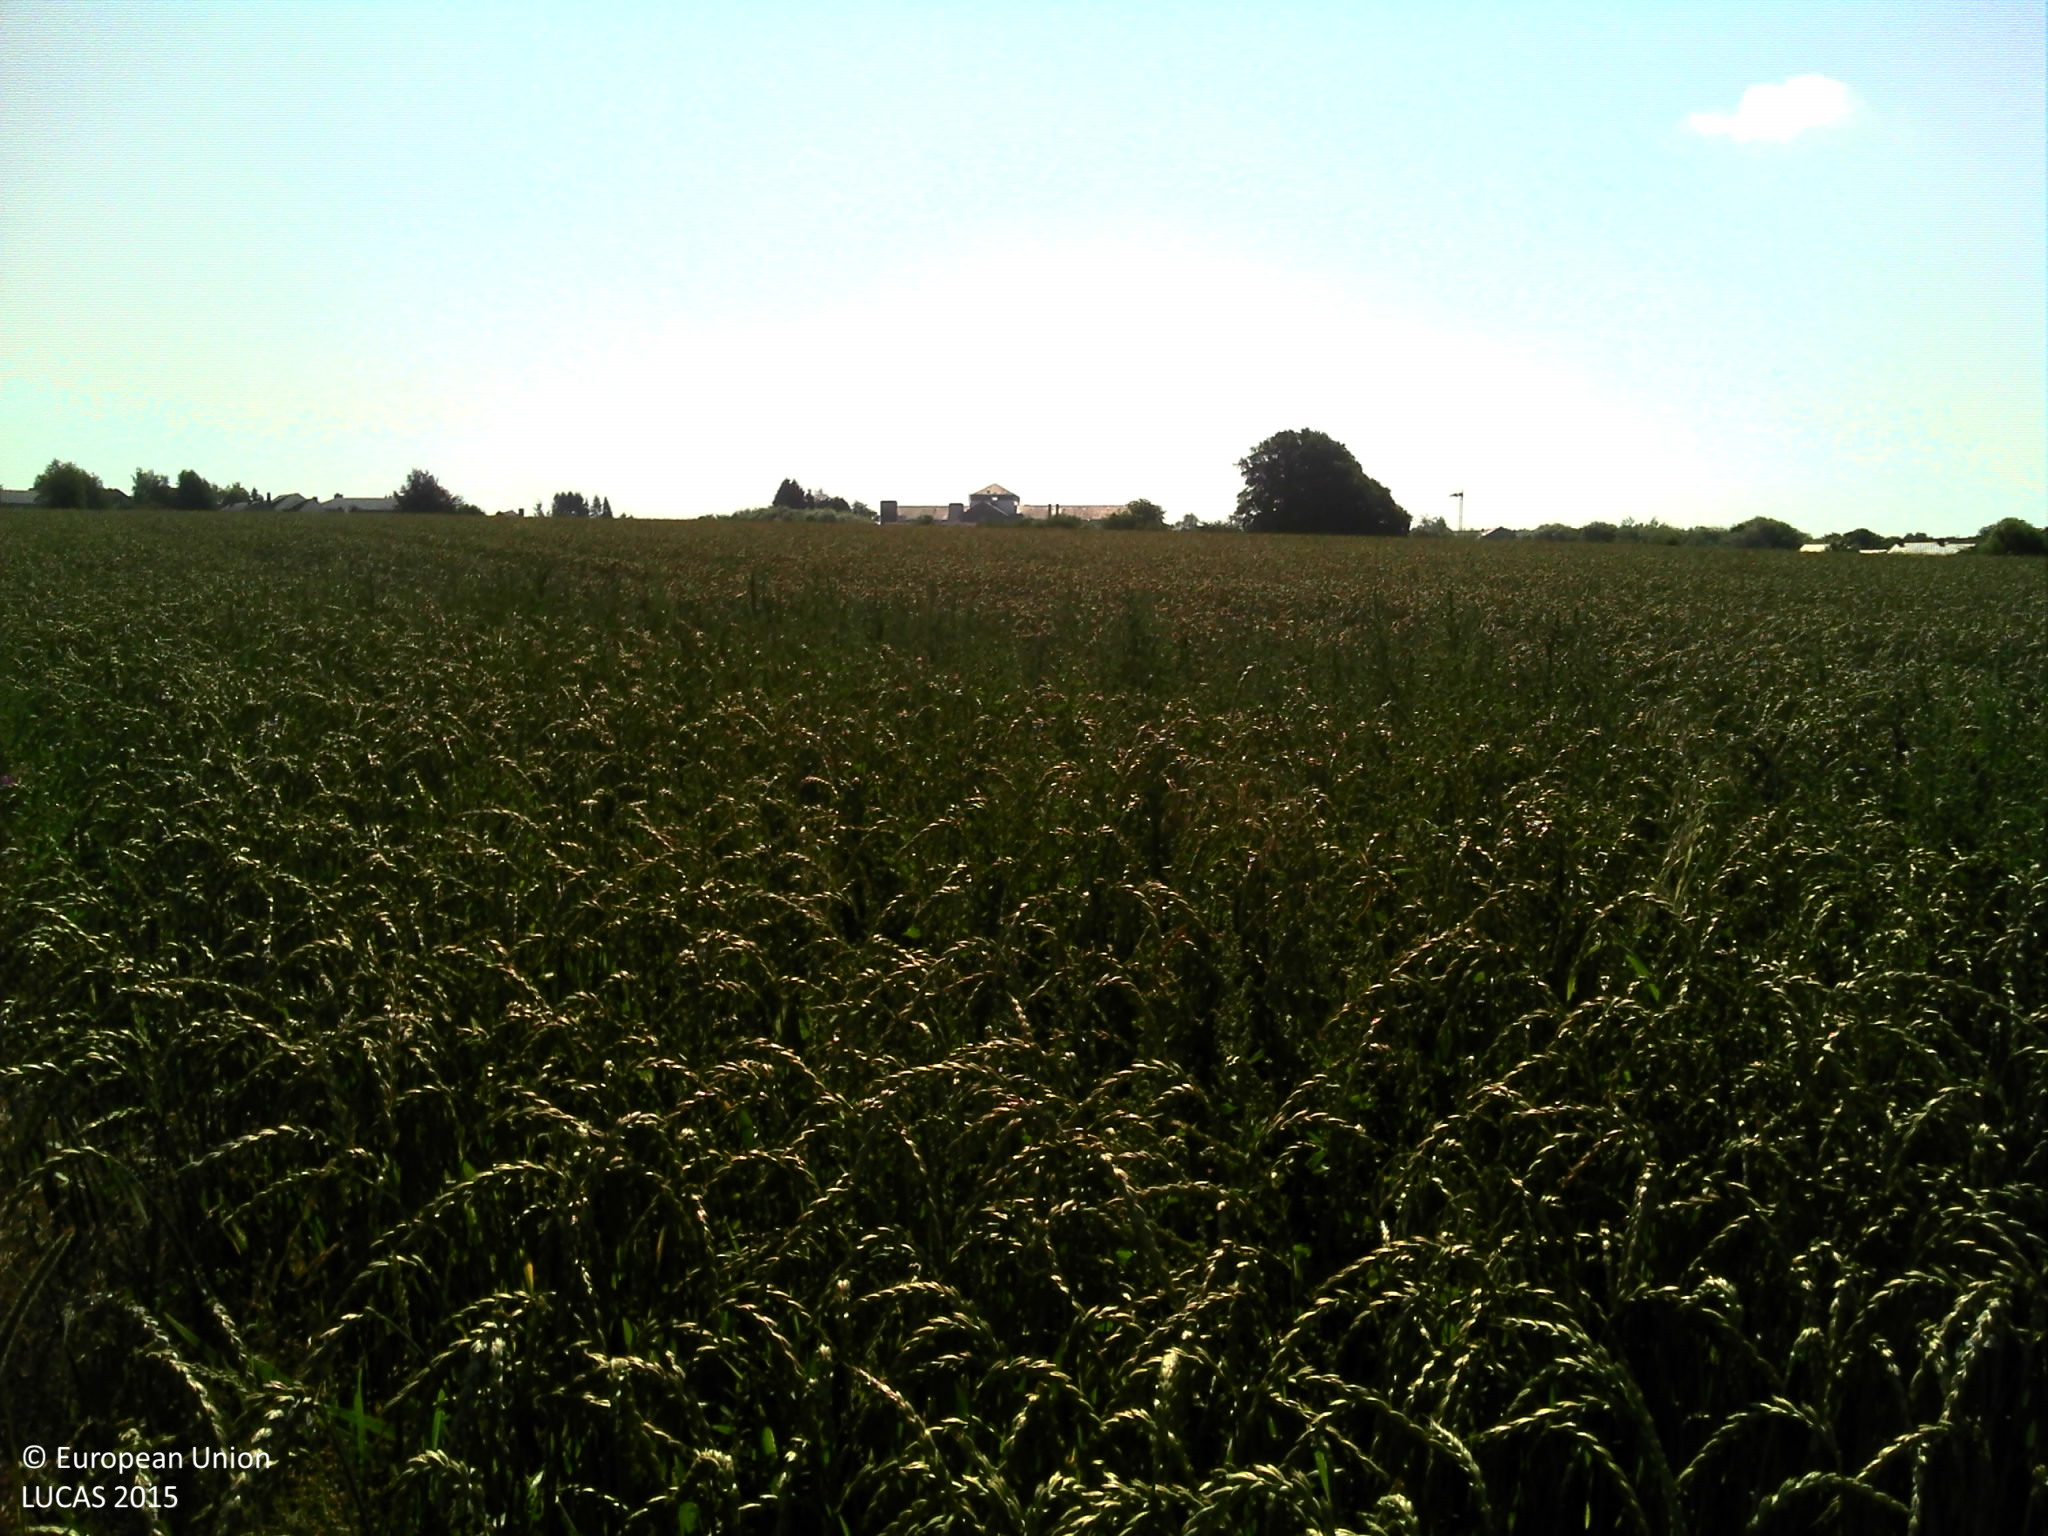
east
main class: Grassland
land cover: Grassland without tree/shrub cover
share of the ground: > 75 %
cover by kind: herbaceous plants 100 %
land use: Agriculture (excluding fallow land and kitchen gardens)
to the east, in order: Grassland without tree/shrub cover; Fences; Other cereals
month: July
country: BE
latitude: 50.0137
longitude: 5.7145
